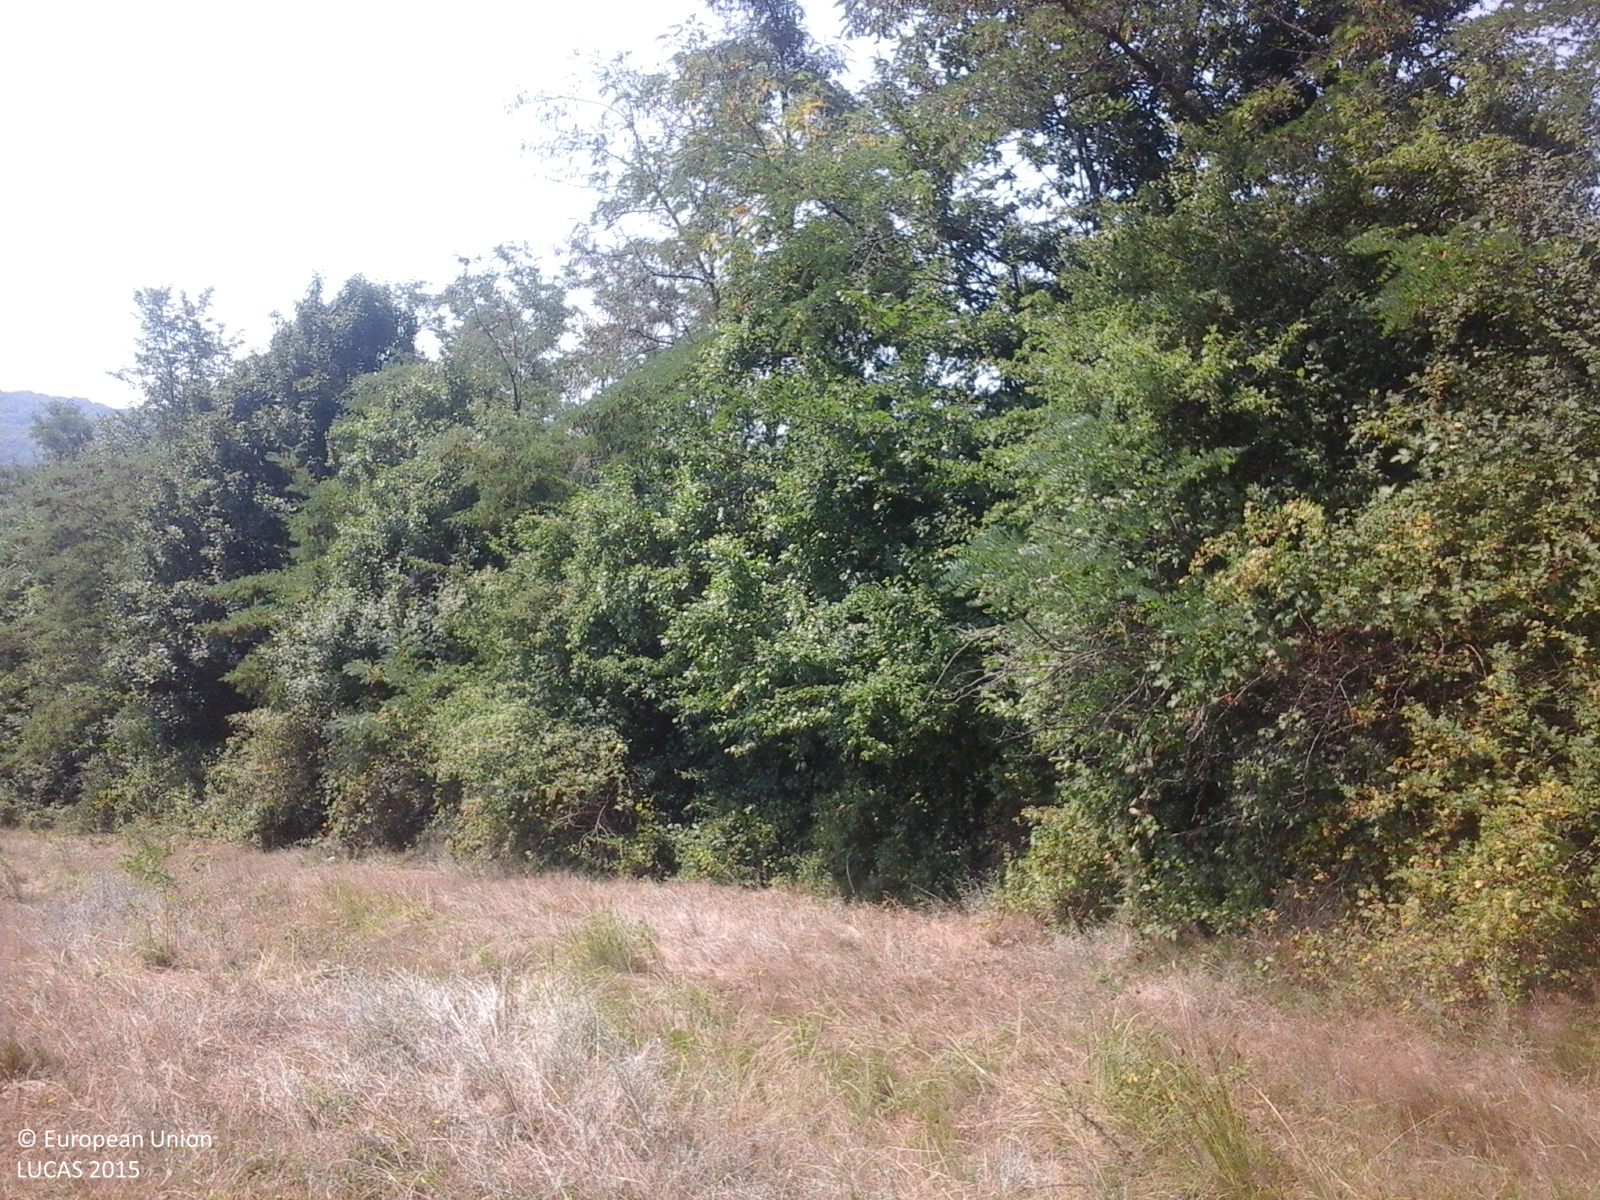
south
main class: Cropland
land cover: Other fruit trees and berries
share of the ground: > 75 %
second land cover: Grassland without tree/shrub cover
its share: > 75 %
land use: Agriculture (excluding fallow land and kitchen gardens)
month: July
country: RO
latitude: 45.1818
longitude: 24.5735
